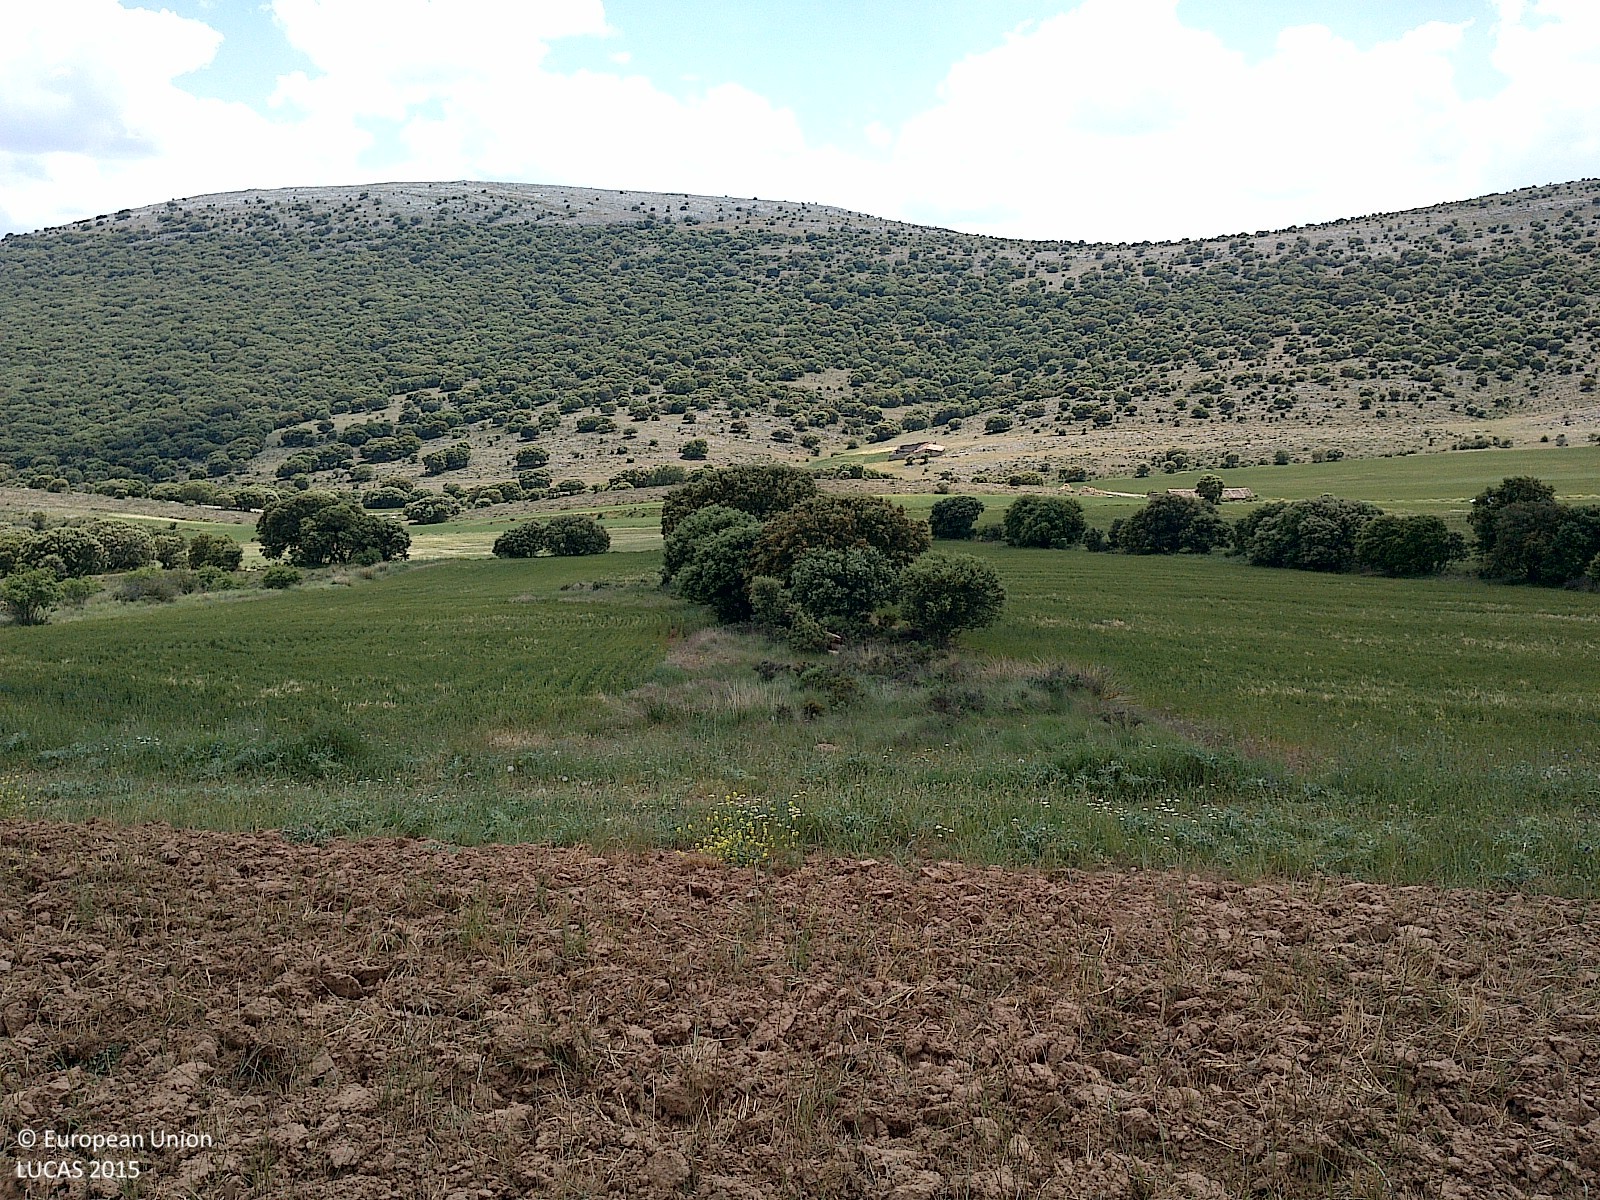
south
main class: Grassland
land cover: Spontaneously vegetated surfaces
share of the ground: 10 - 25 %
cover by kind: unconsolidated bare surface 80 %, herbaceous plants 20 %
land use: Fallow land
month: June
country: ES
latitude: 41.7531
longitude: -2.1692
